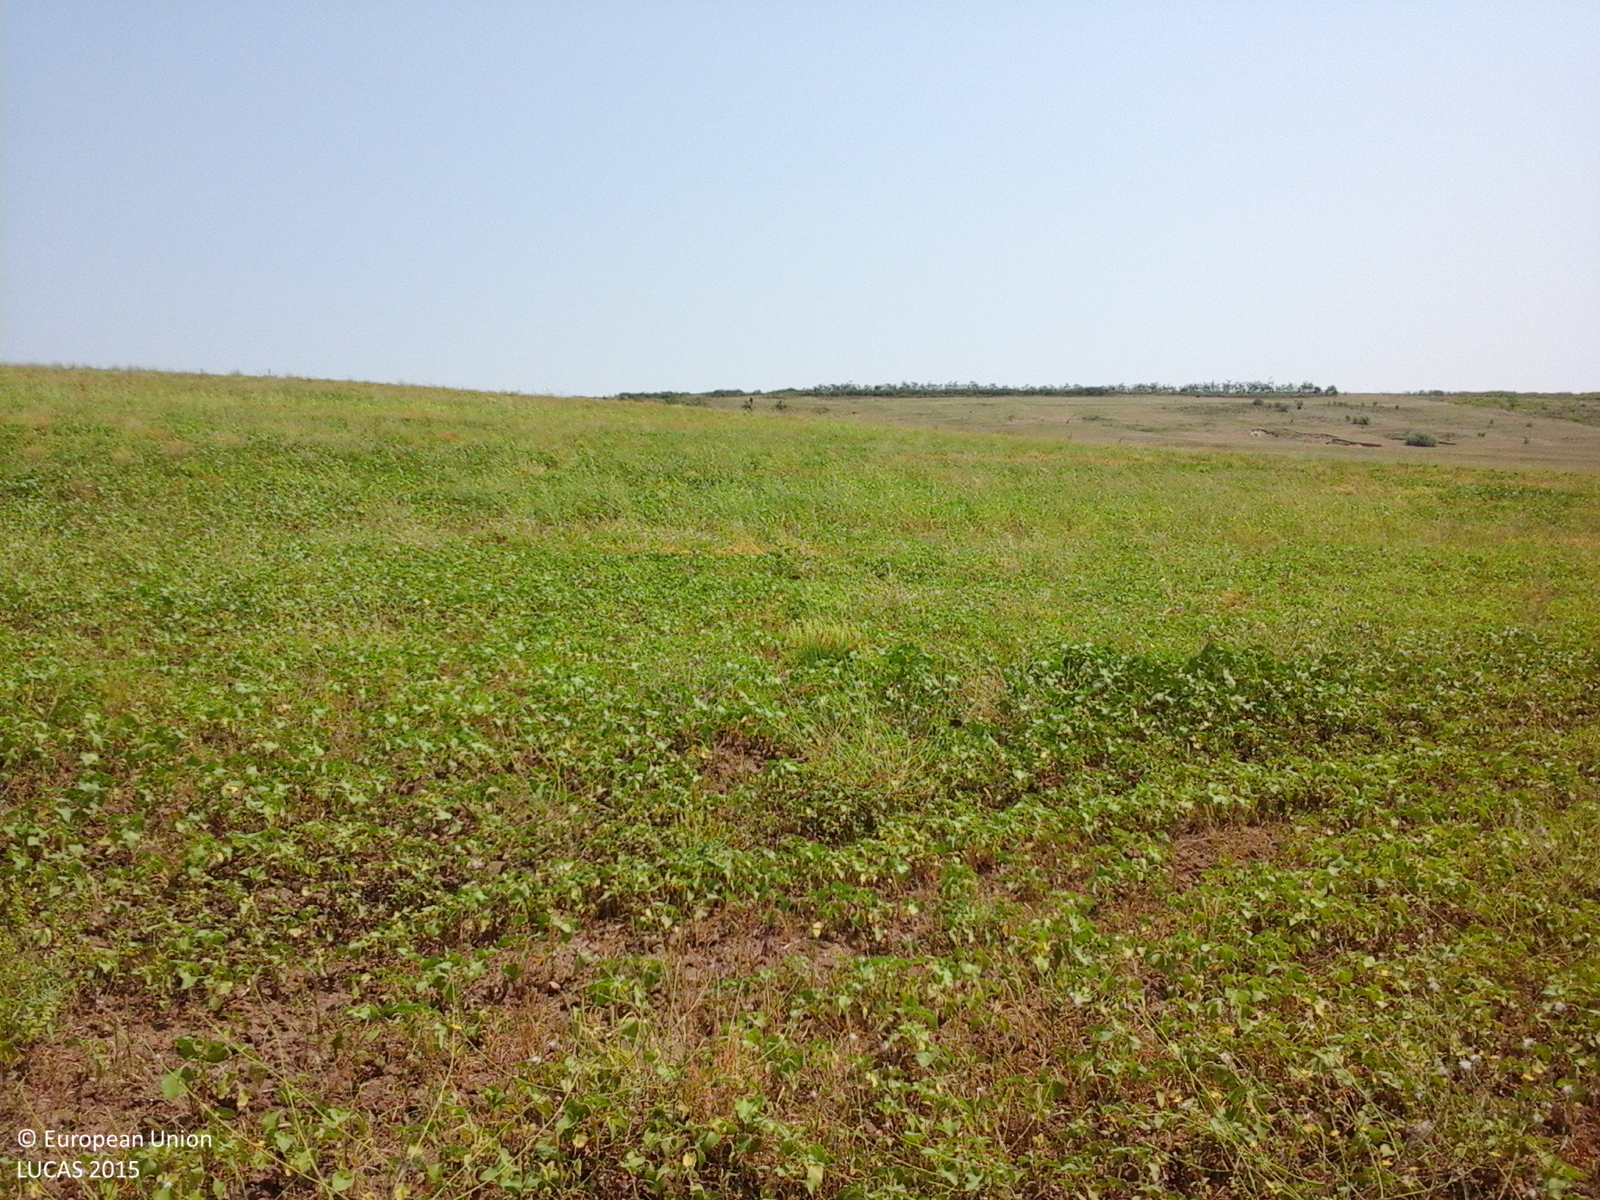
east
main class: Grassland
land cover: Spontaneously vegetated surfaces
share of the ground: > 75 %
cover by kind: herbaceous plants 100 %
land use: Agriculture (excluding fallow land and kitchen gardens)
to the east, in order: Spontaneously vegetated surfaces; Grassland without tree/shrub cover; Tracks; Grassland with sparse tree/shrub cover; Grassland without tree/shrub cover
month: July
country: RO
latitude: 45.8090
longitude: 27.9677
